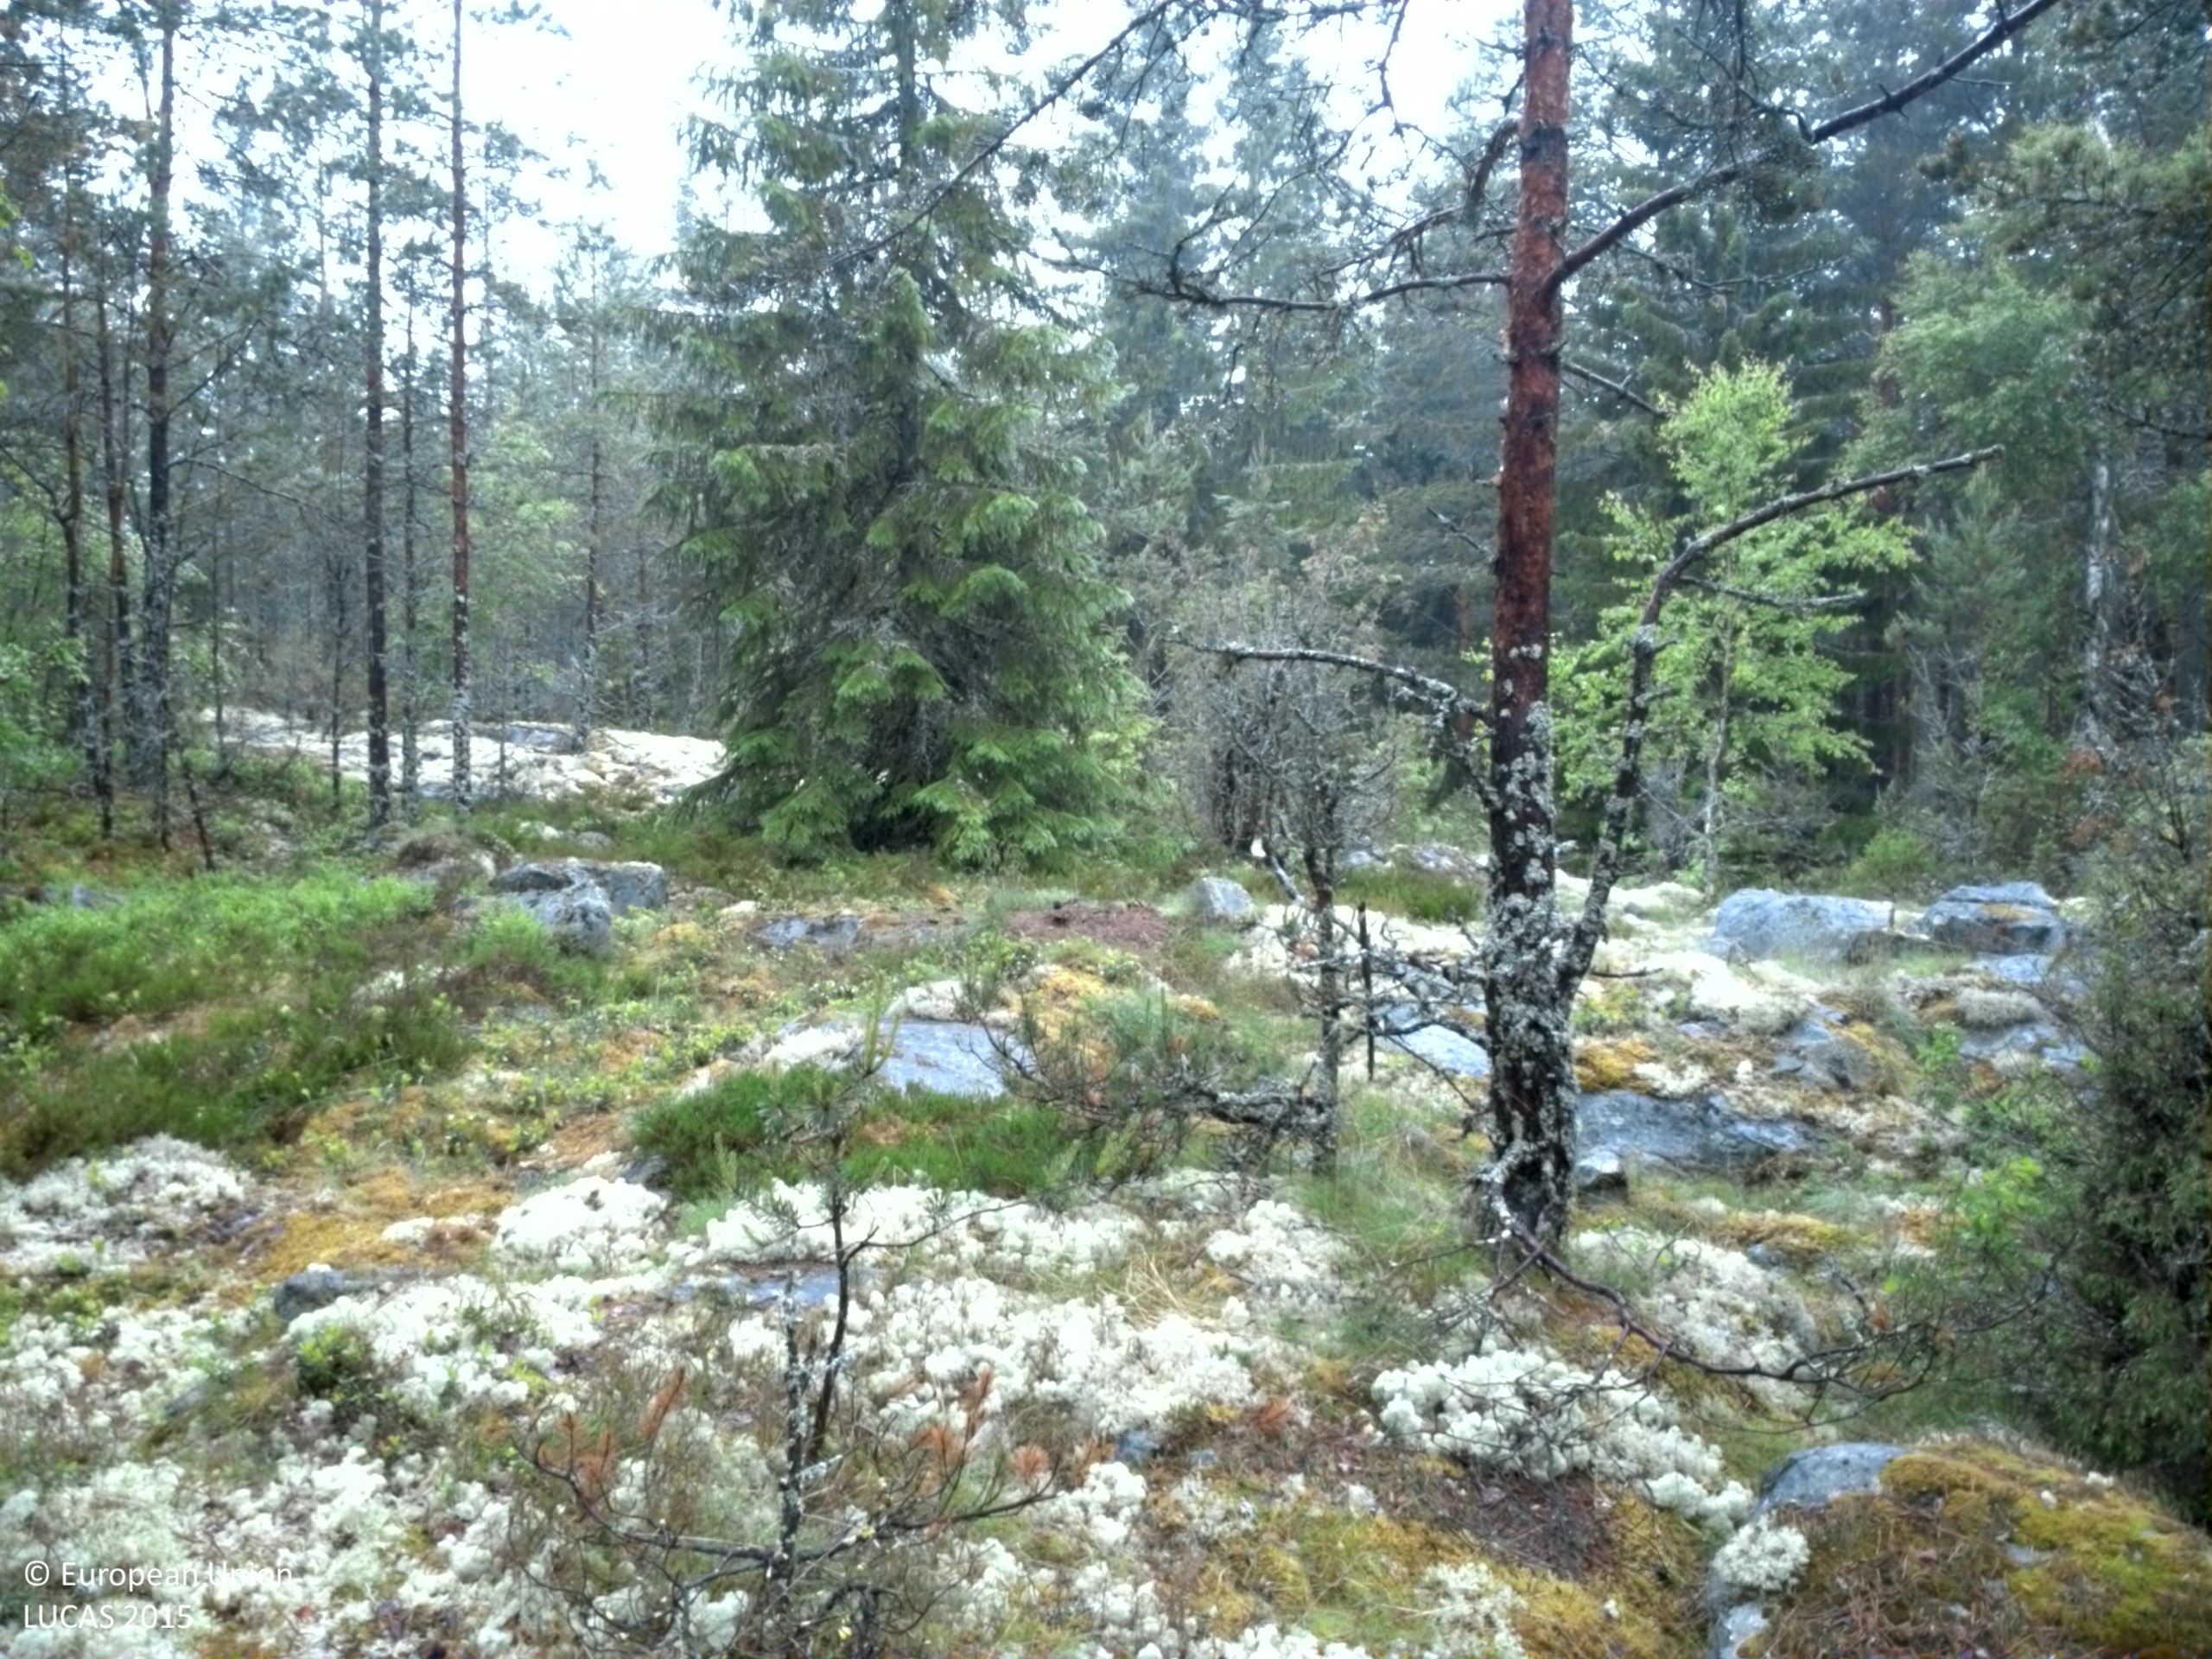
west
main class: Woodland
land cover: Pine dominated coniferous woodland
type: boreal forest
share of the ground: 50 - 75 %
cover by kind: coniferous forest trees 60 %, lichens and mosses 20 %, broadleaved forest trees 5 %, shrubs 5 %, herbaceous plants 5 %, consolidated bare surface 5 %
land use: Forestry
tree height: > 5 m
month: June
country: SE
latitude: 60.3643
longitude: 18.0978
